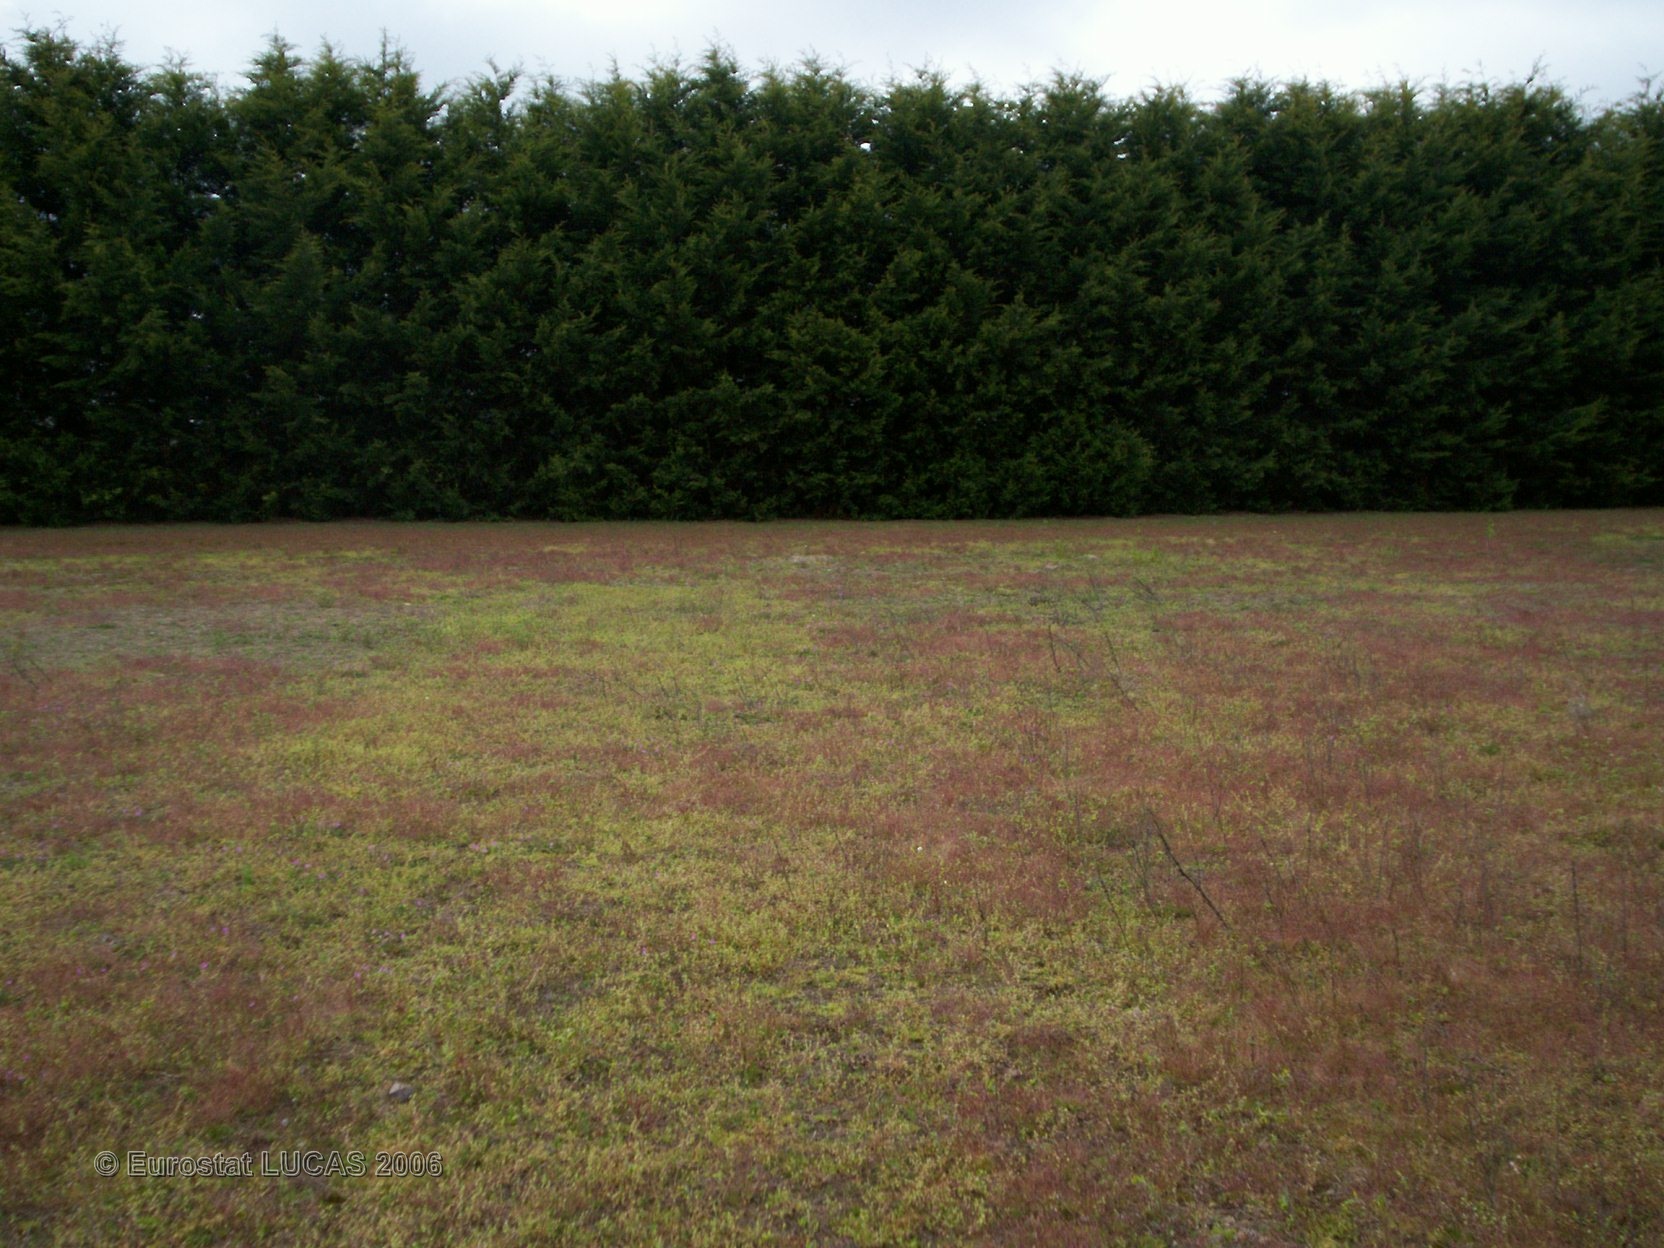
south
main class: Grassland
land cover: Grassland without tree/shrub cover
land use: Agriculture (excluding fallow land and kitchen gardens)
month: April
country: FR
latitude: 47.4566
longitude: -0.4159
